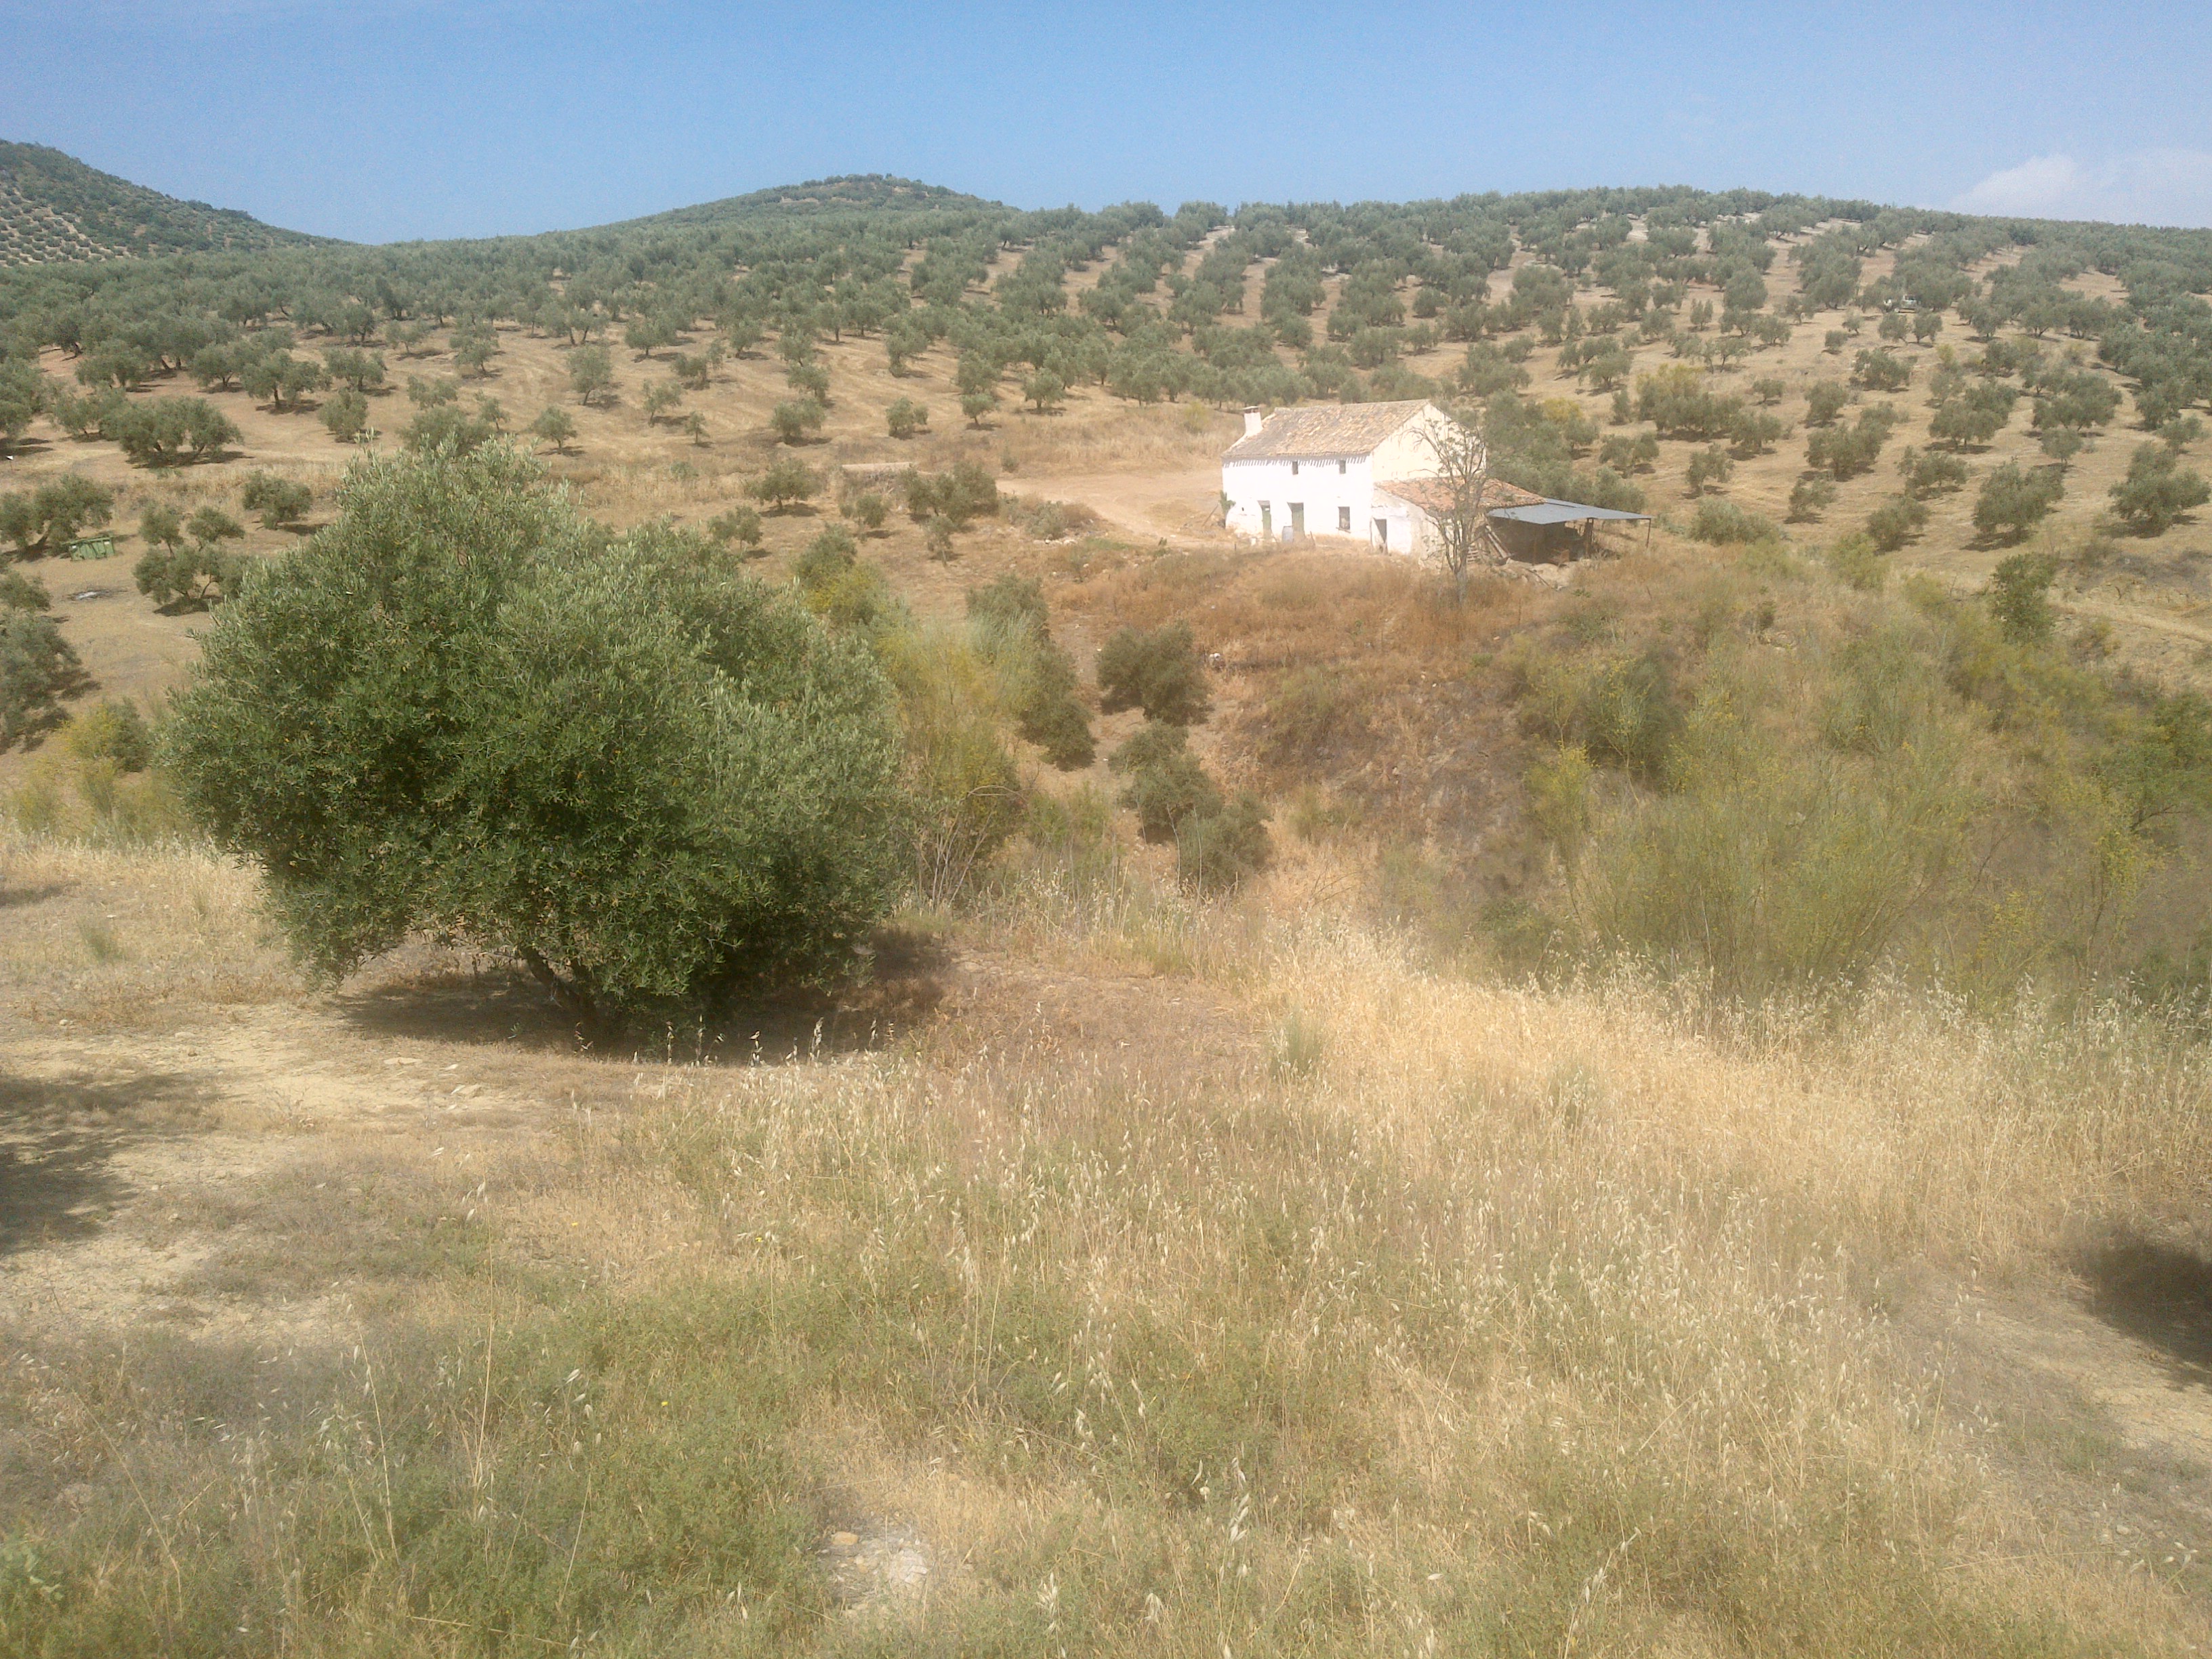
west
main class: Cropland
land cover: Olive groves
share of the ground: 10 - 25 %
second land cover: Spontaneously vegetated surfaces
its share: 50 - 75 %
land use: Agriculture (excluding fallow land and kitchen gardens)
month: May
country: ES
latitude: 37.5168
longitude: -4.1087
